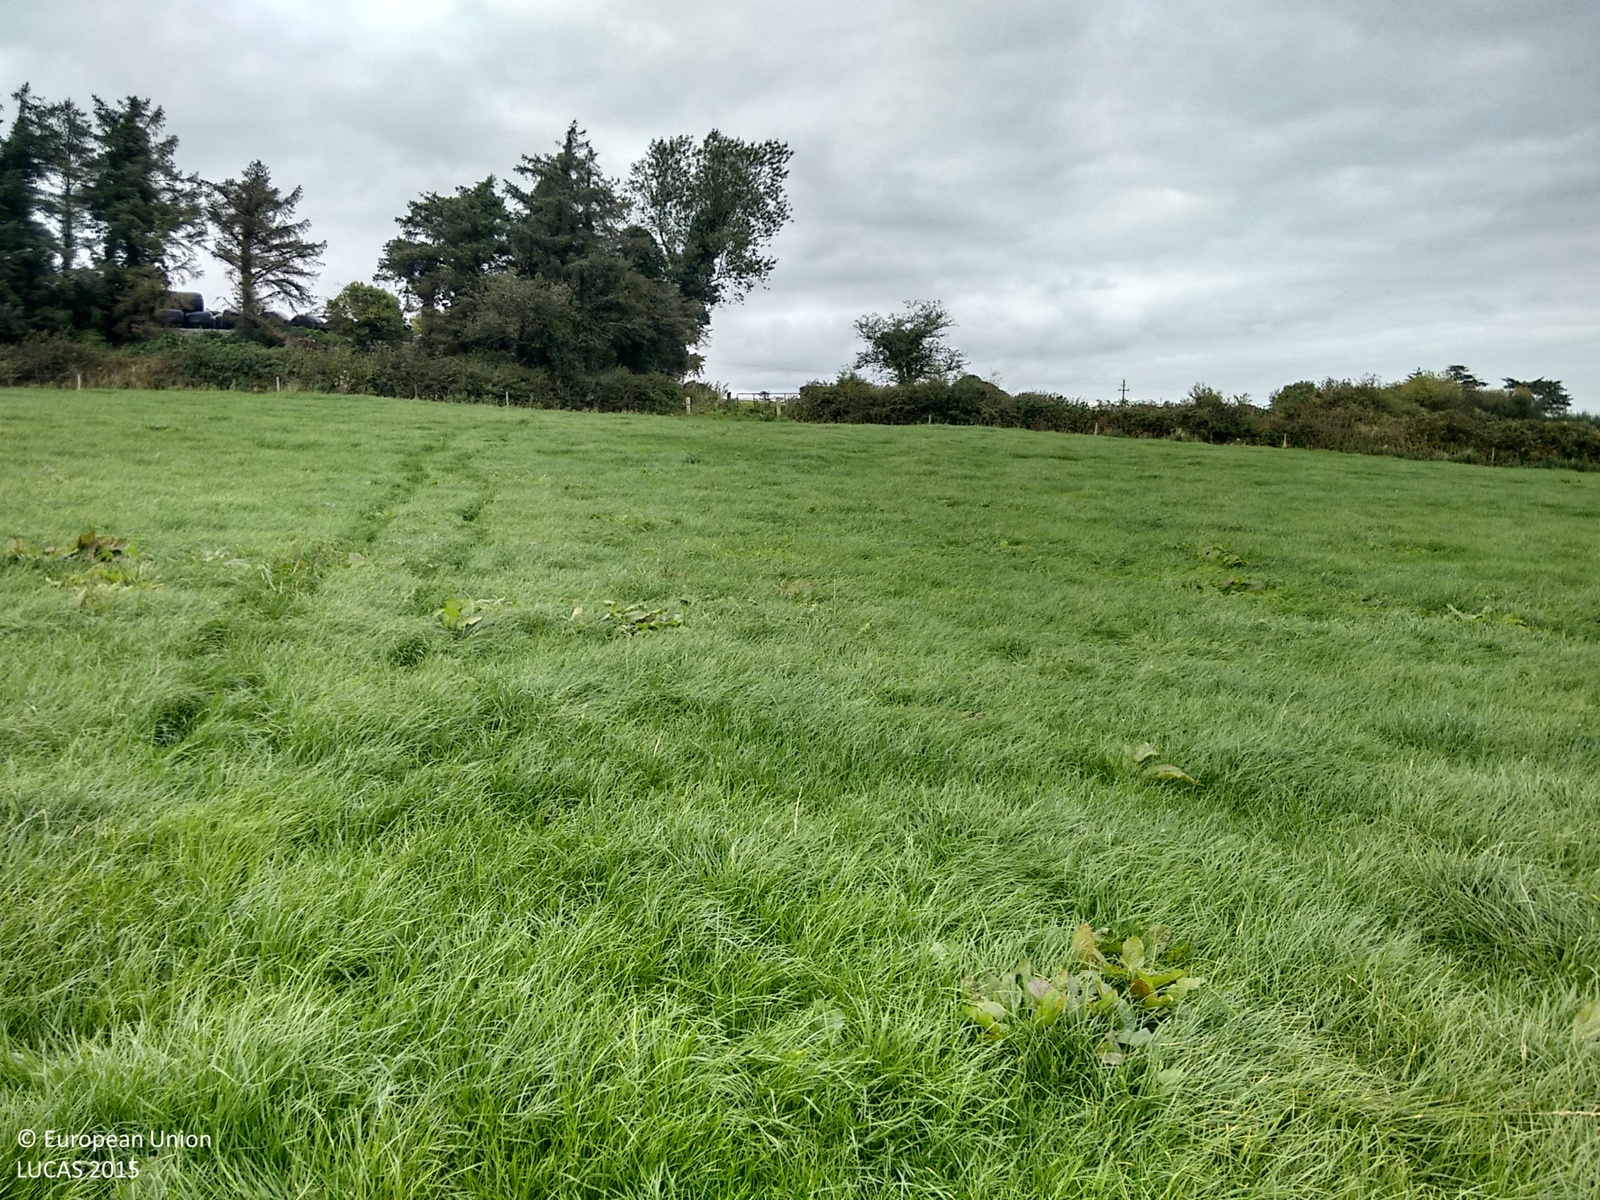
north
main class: Grassland
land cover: Grassland without tree/shrub cover
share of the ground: > 75 %
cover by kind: herbaceous plants 100 %
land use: Agriculture (excluding fallow land and kitchen gardens)
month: September
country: IE
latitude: 52.3332
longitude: -8.9209
